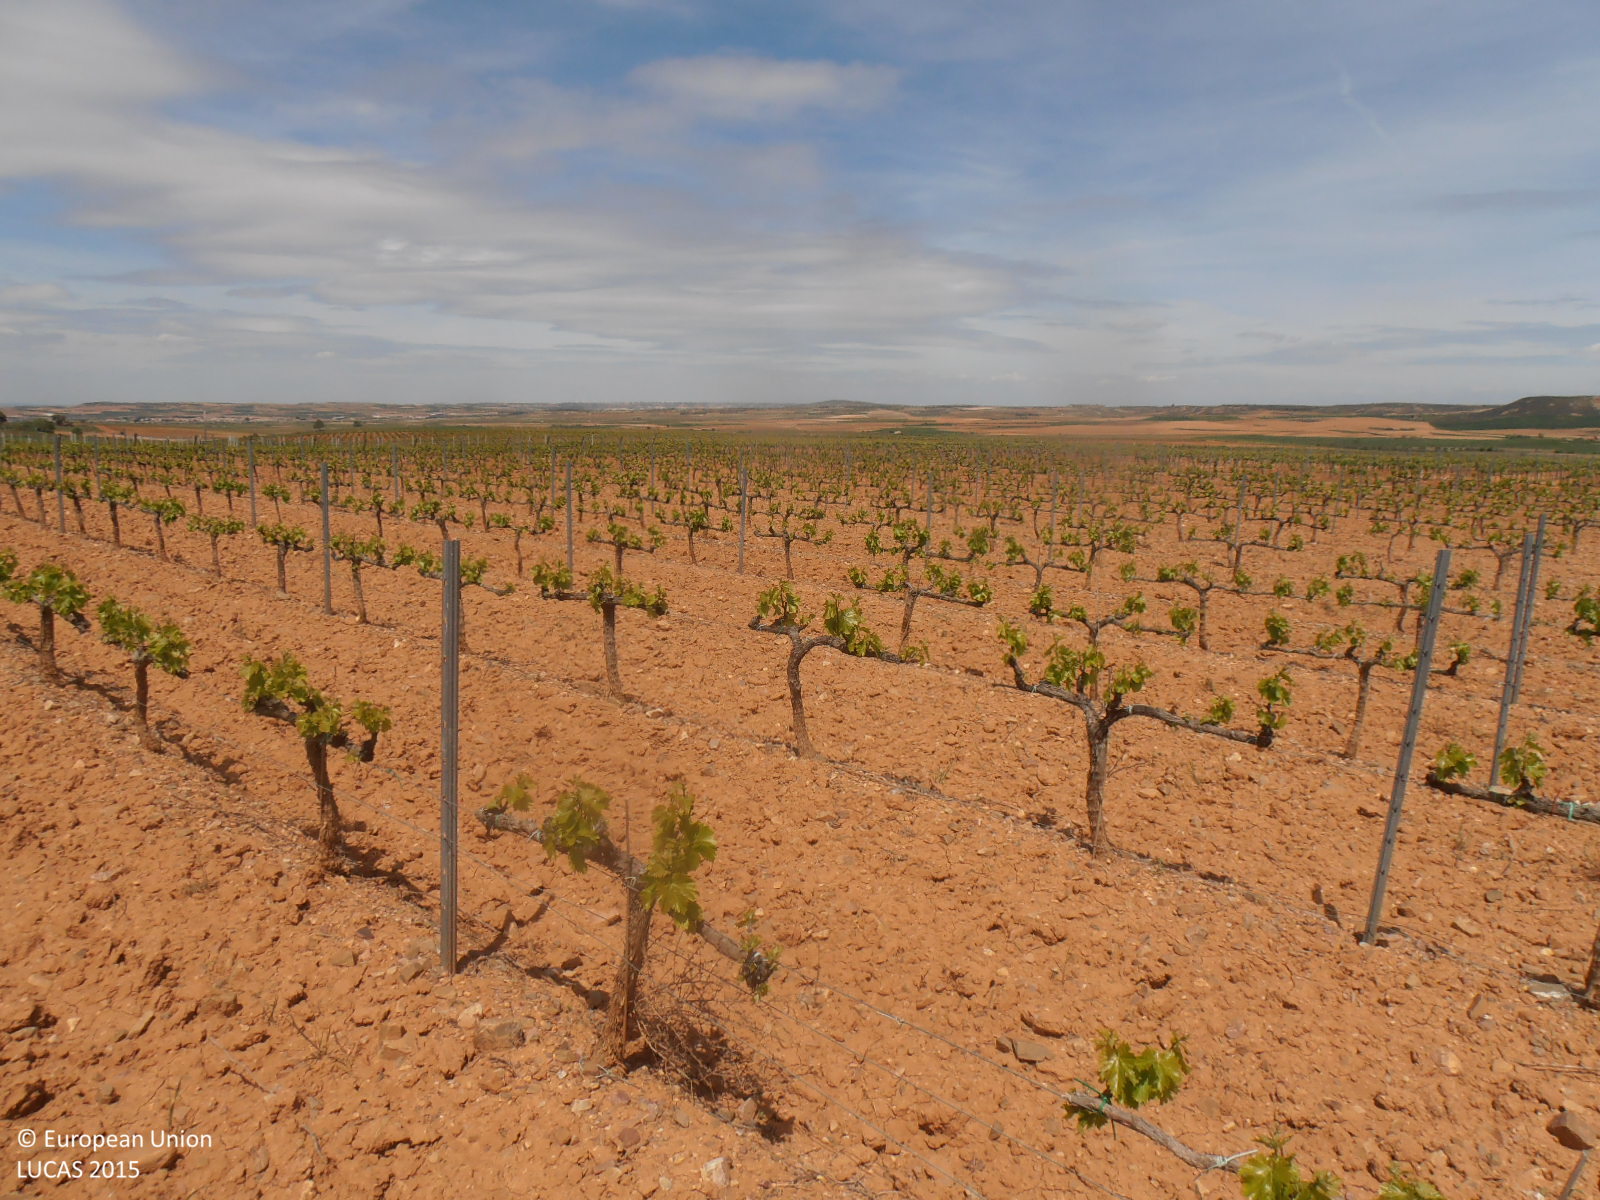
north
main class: Cropland
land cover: Vineyards
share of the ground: < 10 %
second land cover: Other bare soil
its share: > 75 %
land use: Agriculture (excluding fallow land and kitchen gardens)
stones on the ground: < 10 %
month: April
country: ES
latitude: 41.3622
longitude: -1.1505
